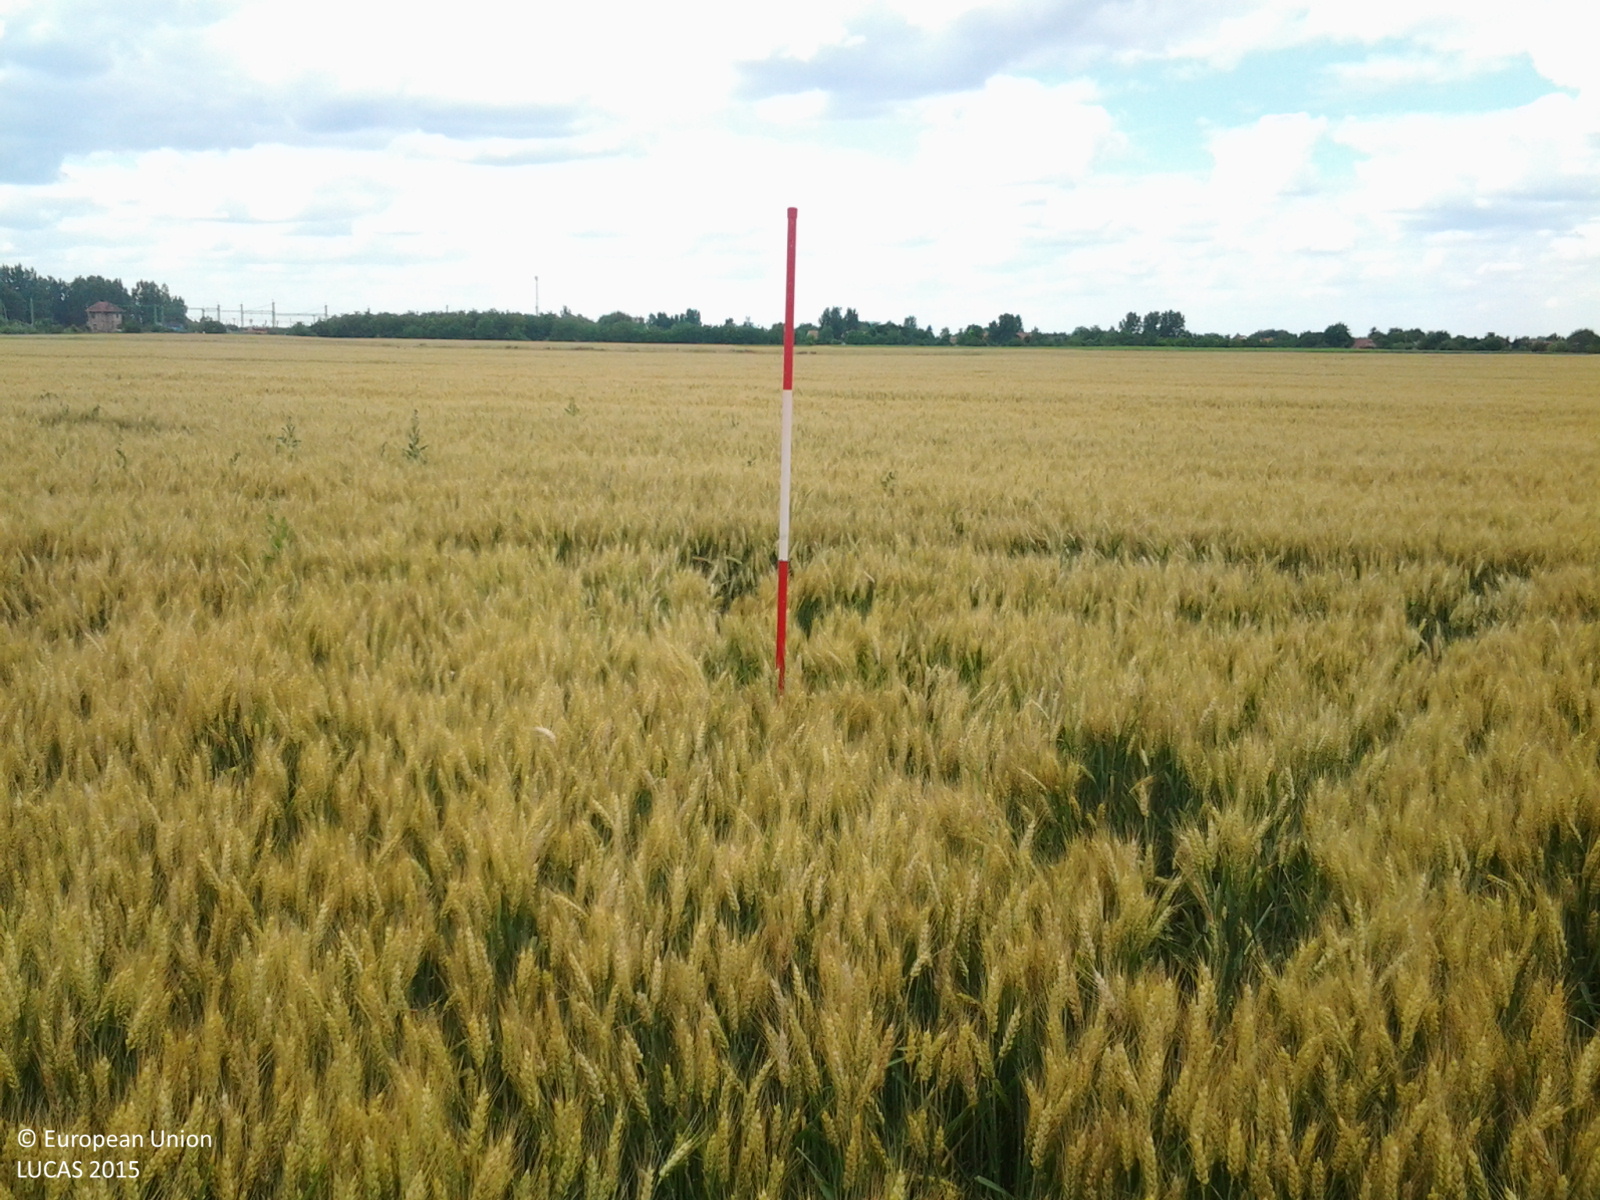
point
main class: Cropland
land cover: Common wheat
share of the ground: > 75 %
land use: Agriculture (excluding fallow land and kitchen gardens)
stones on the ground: < 10 %
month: June
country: HU
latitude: 46.5264
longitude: 21.1803
